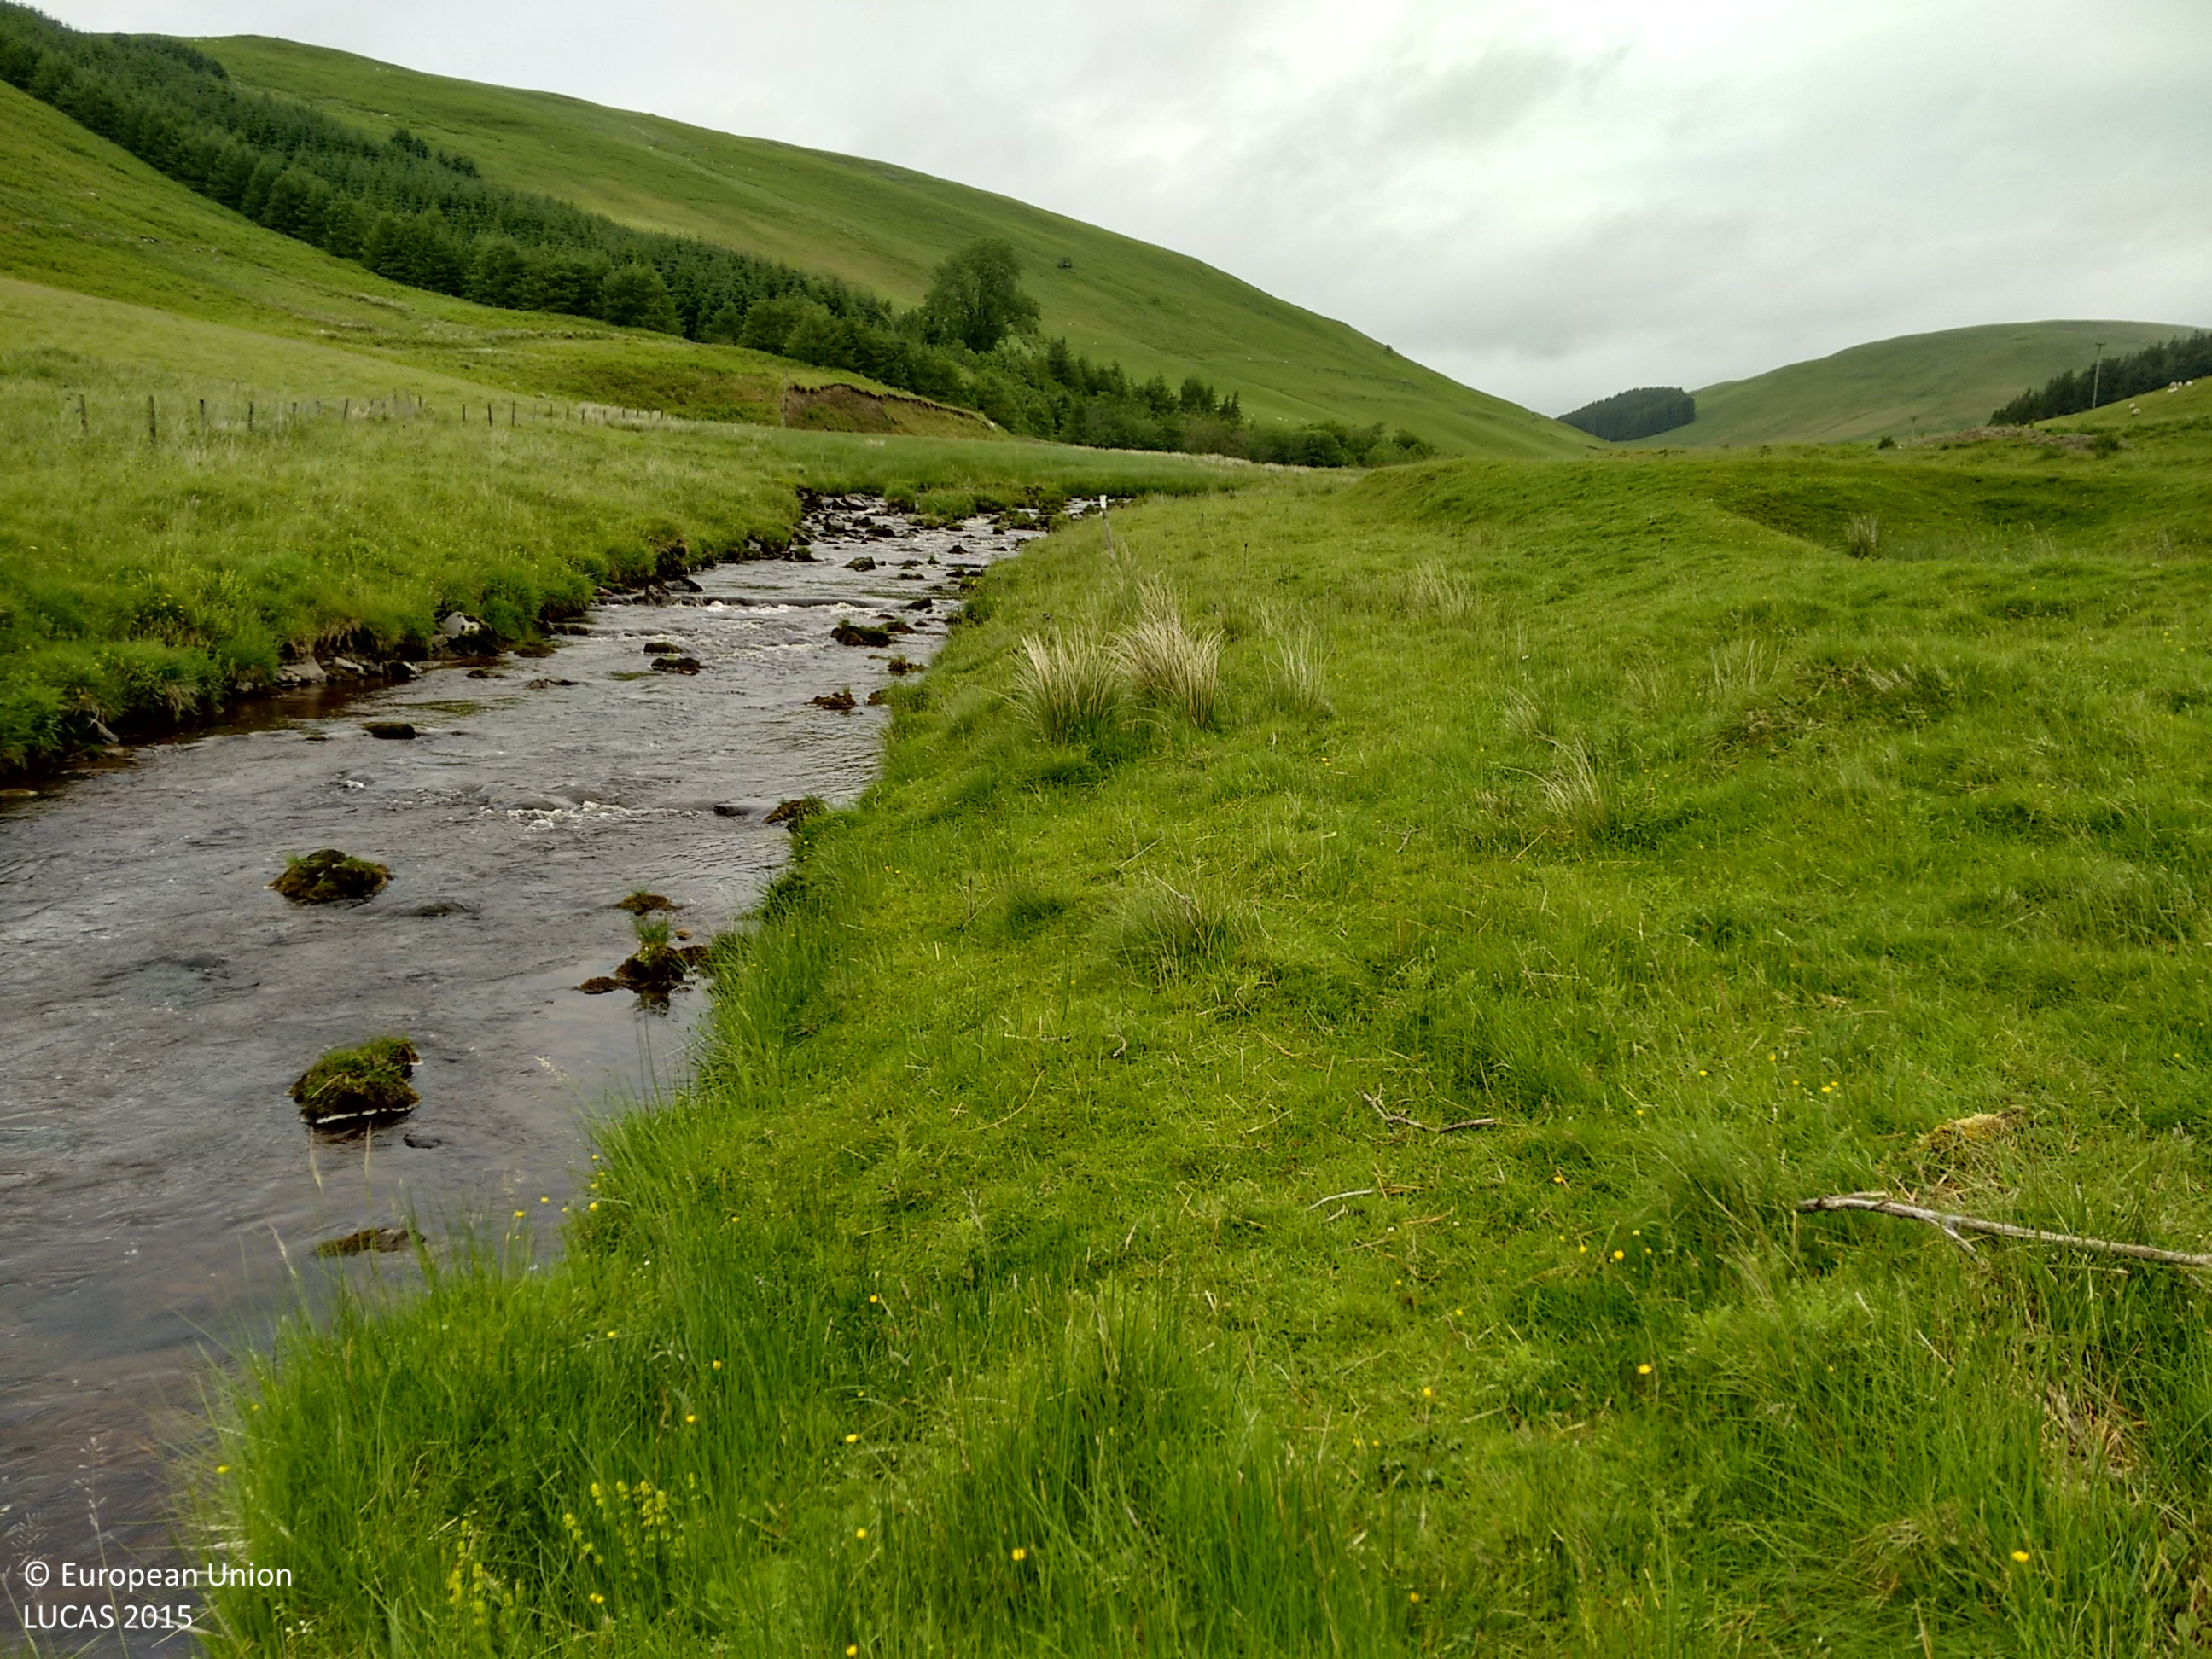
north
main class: Grassland
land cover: Grassland without tree/shrub cover
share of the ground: > 75 %
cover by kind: herbaceous plants 100 %
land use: Agriculture (excluding fallow land and kitchen gardens)
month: June
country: GB
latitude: 55.2378
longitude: -3.1095
